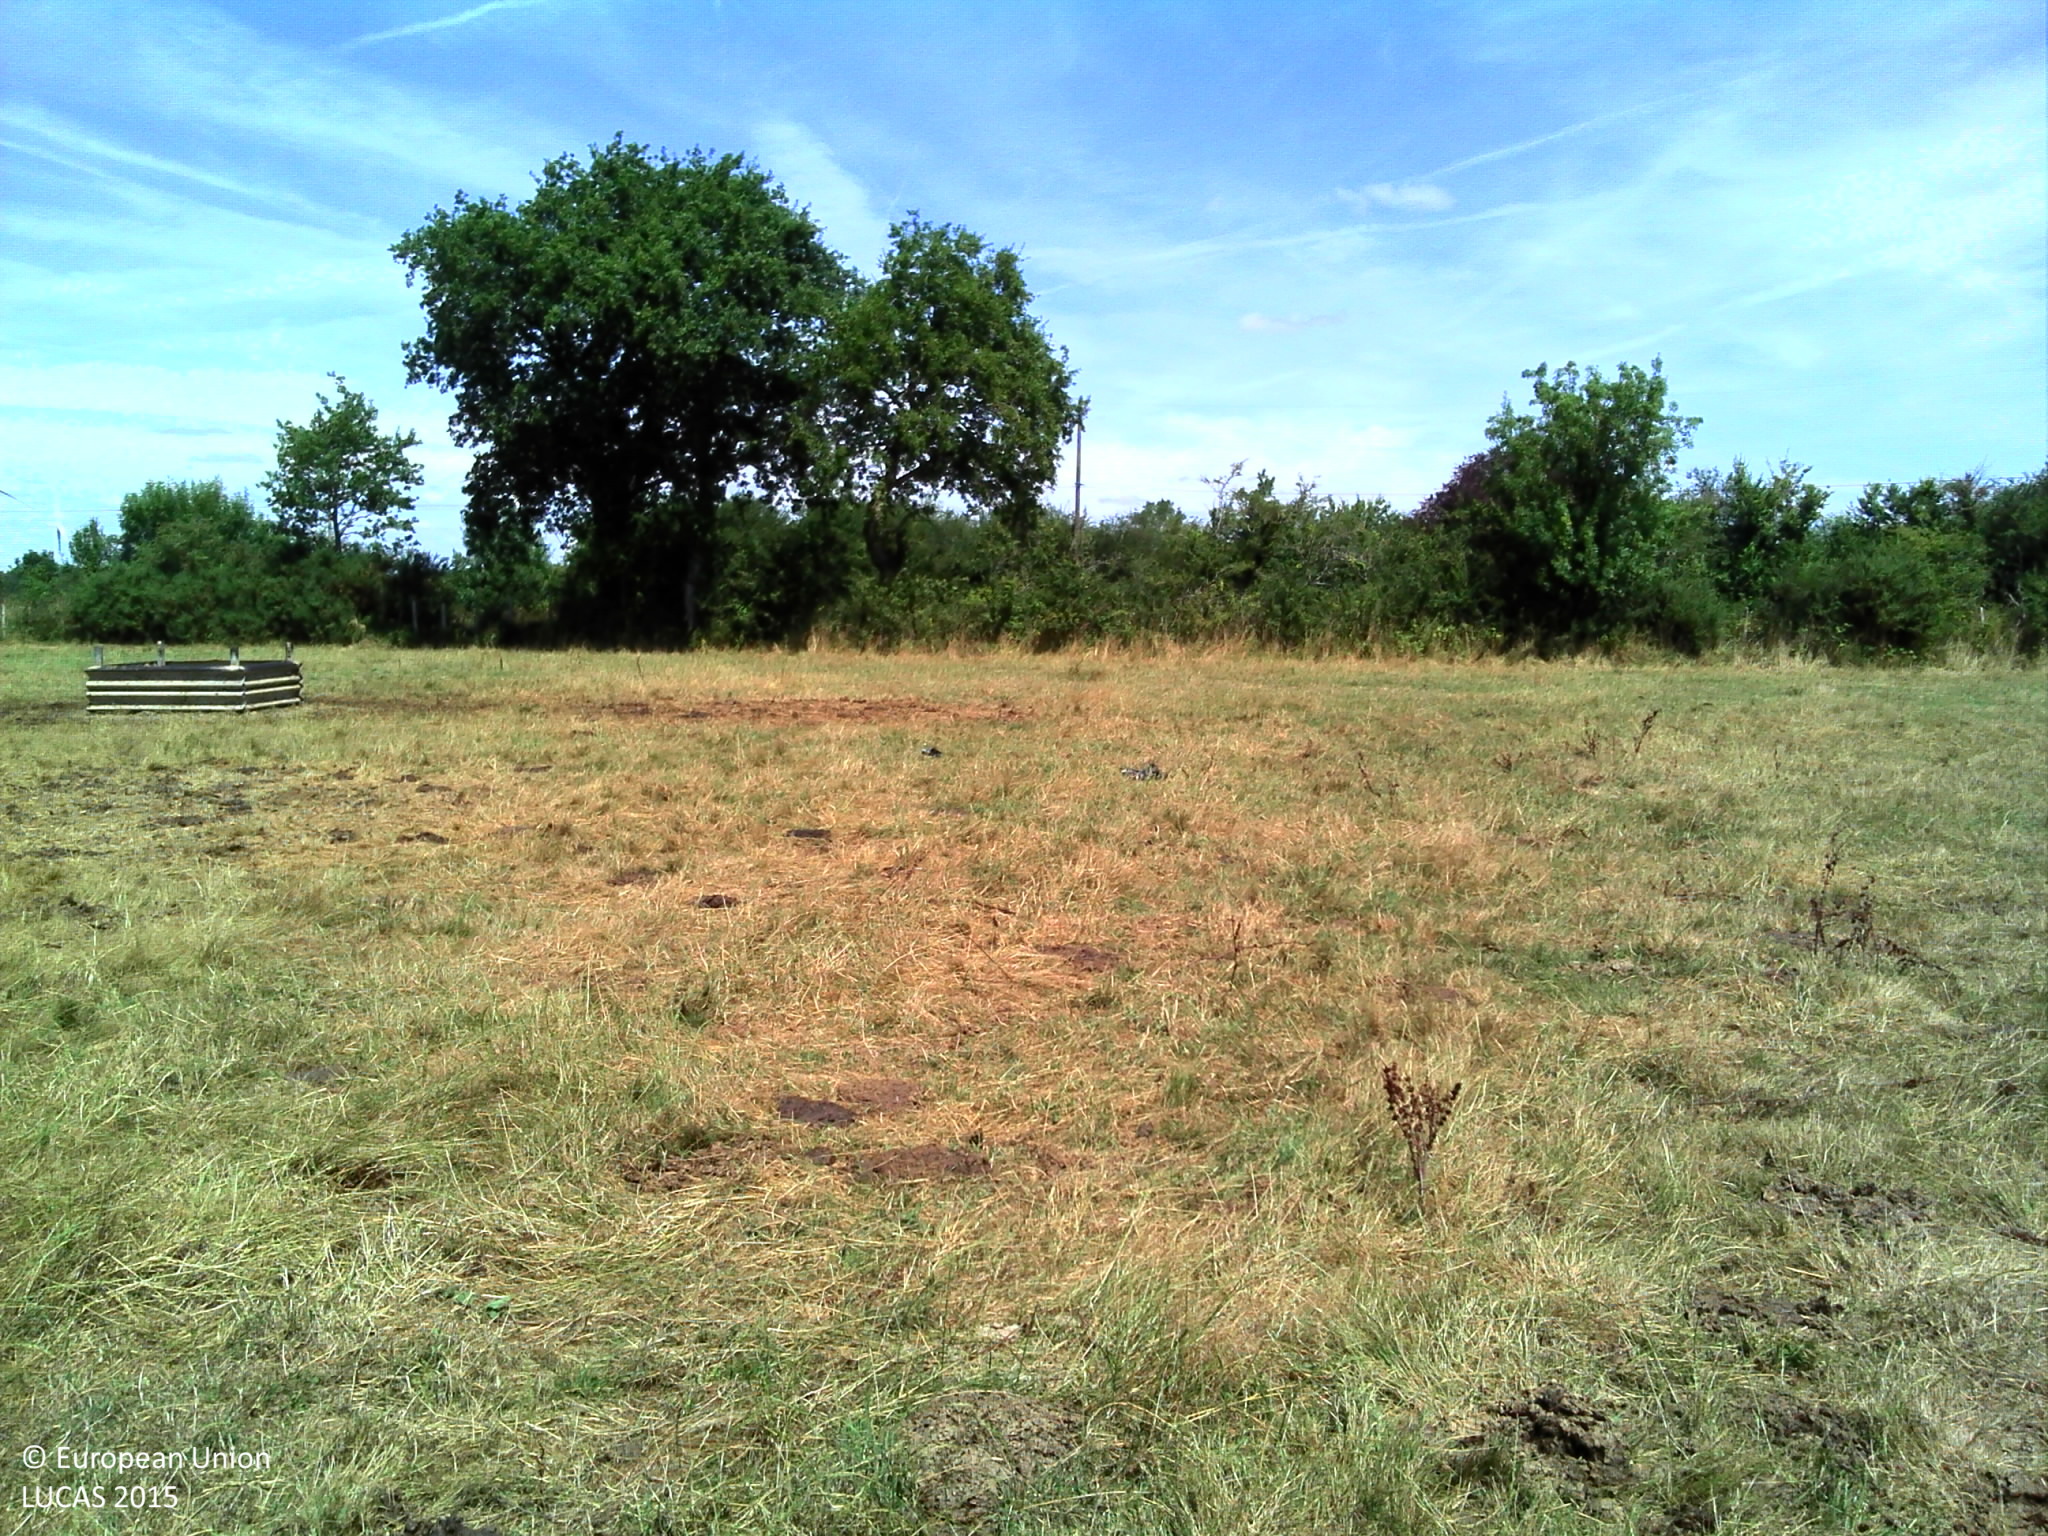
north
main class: Cropland
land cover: Temporary grasslands
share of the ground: > 75 %
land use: Agriculture (excluding fallow land and kitchen gardens)
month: July
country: FR
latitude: 47.4000
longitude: -2.0142
